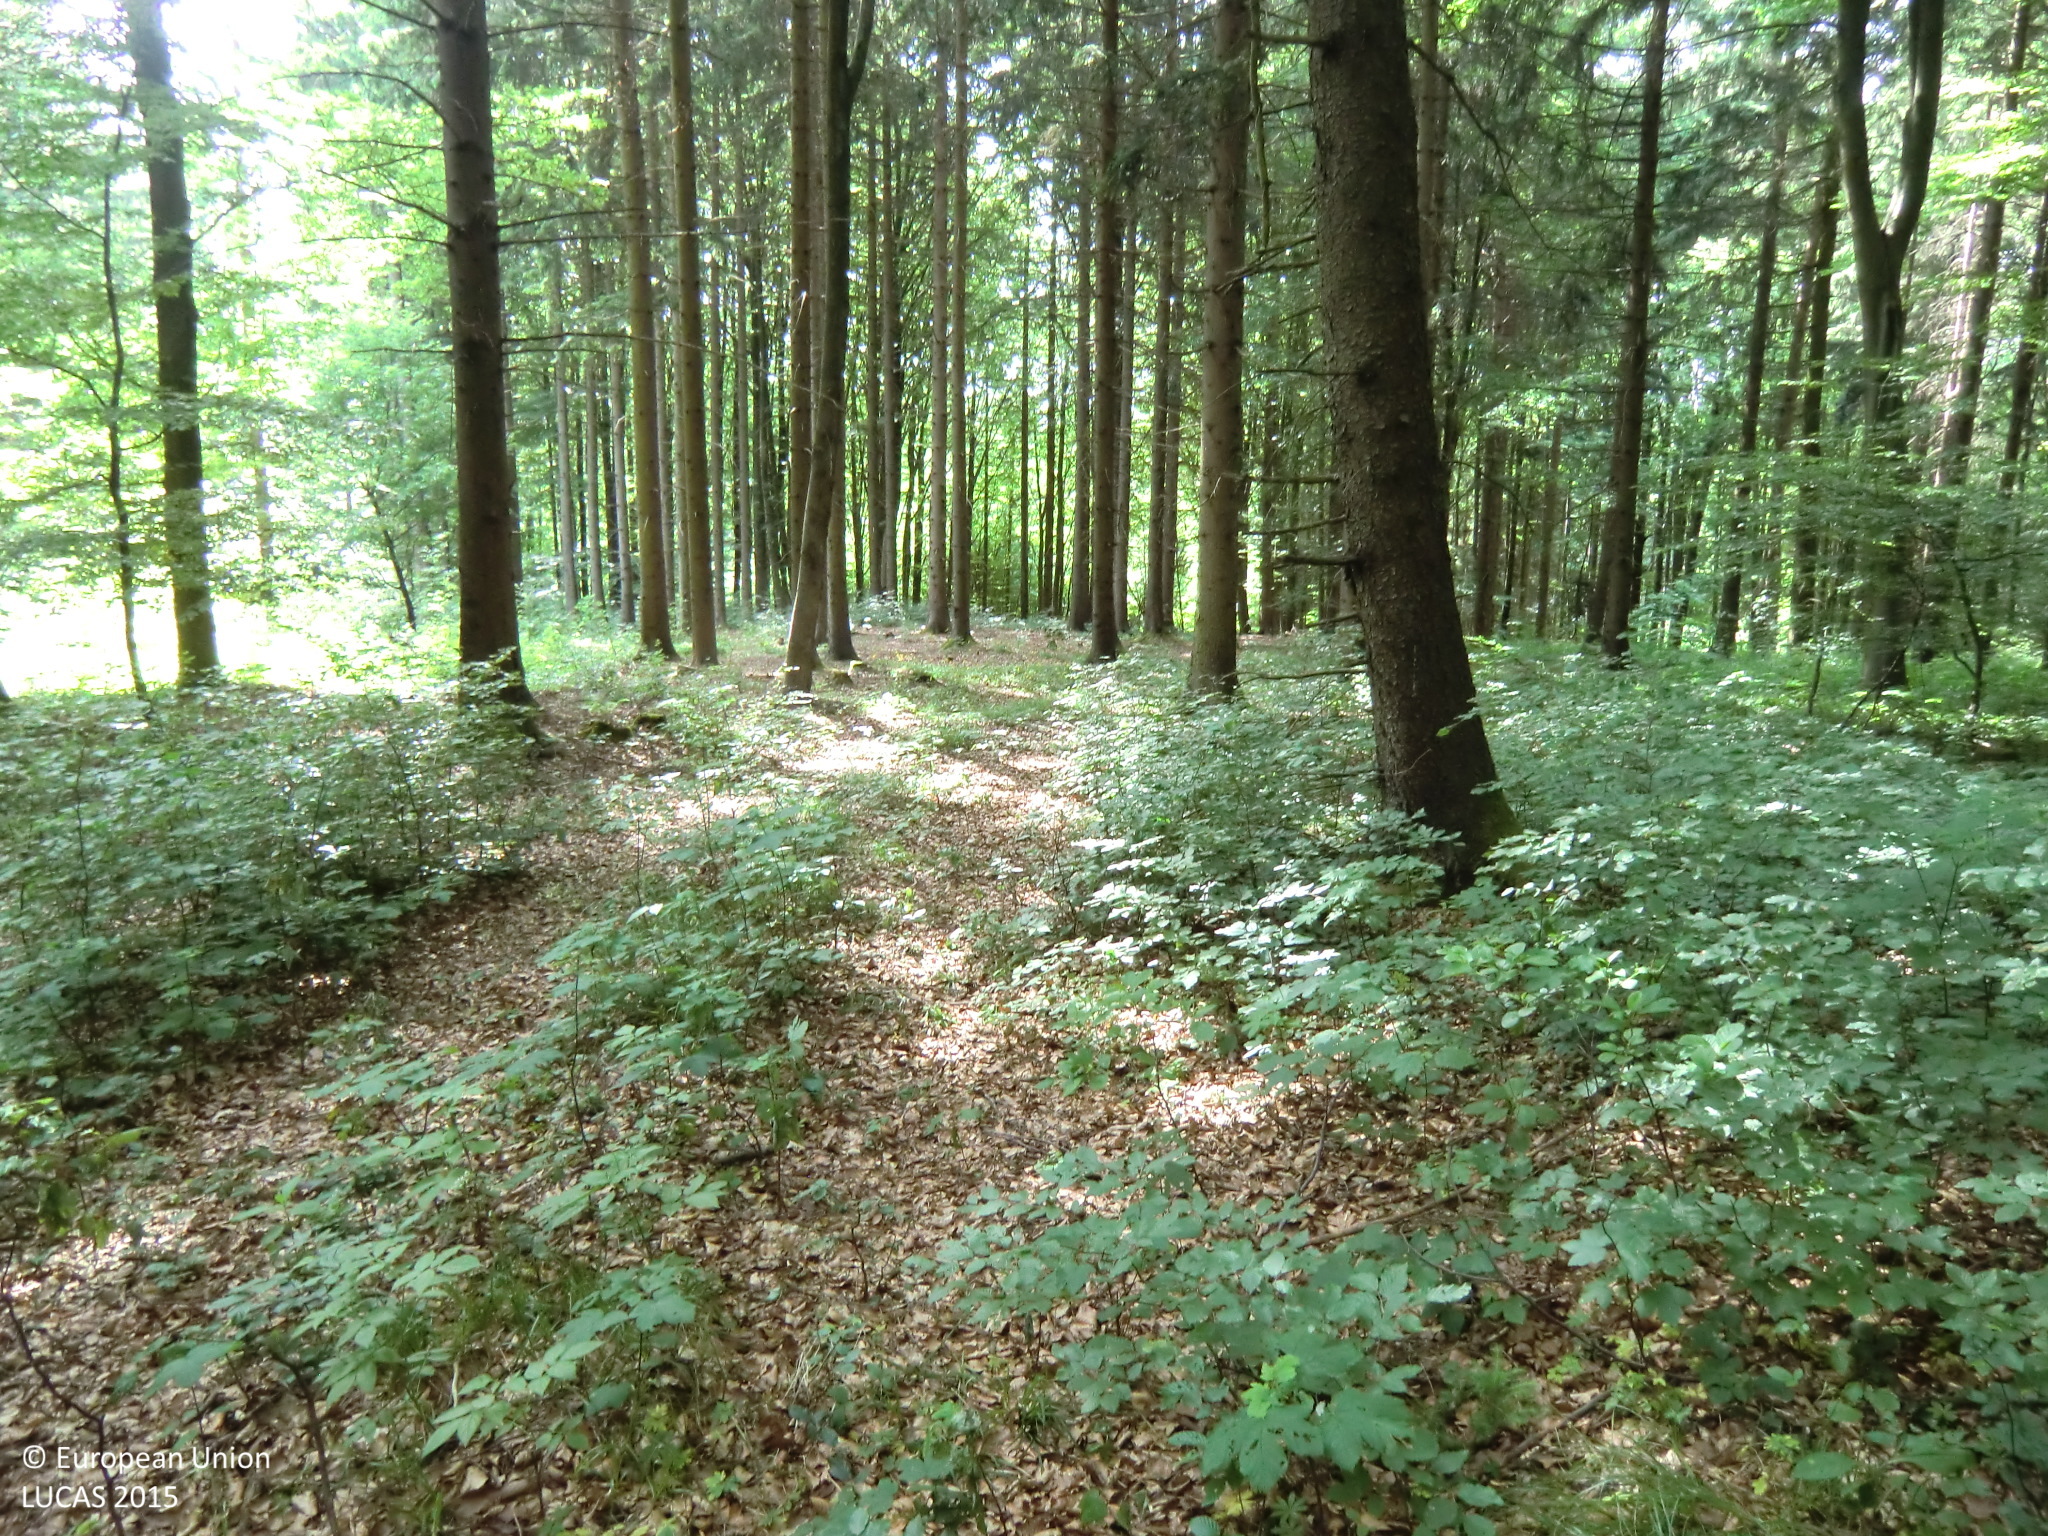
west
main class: Woodland
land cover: Spruce dominated mixed woodland
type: hemiboreal forest and nemoral coniferous forest and mixed broadleaved-coniferous forest
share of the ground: > 75 %
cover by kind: coniferous forest trees 45 %, broadleaved forest trees 45 %, shrubs 5 %, herbaceous plants 5 %
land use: Forestry
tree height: > 5 m
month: May
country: AT
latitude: 48.2161
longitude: 15.0483
